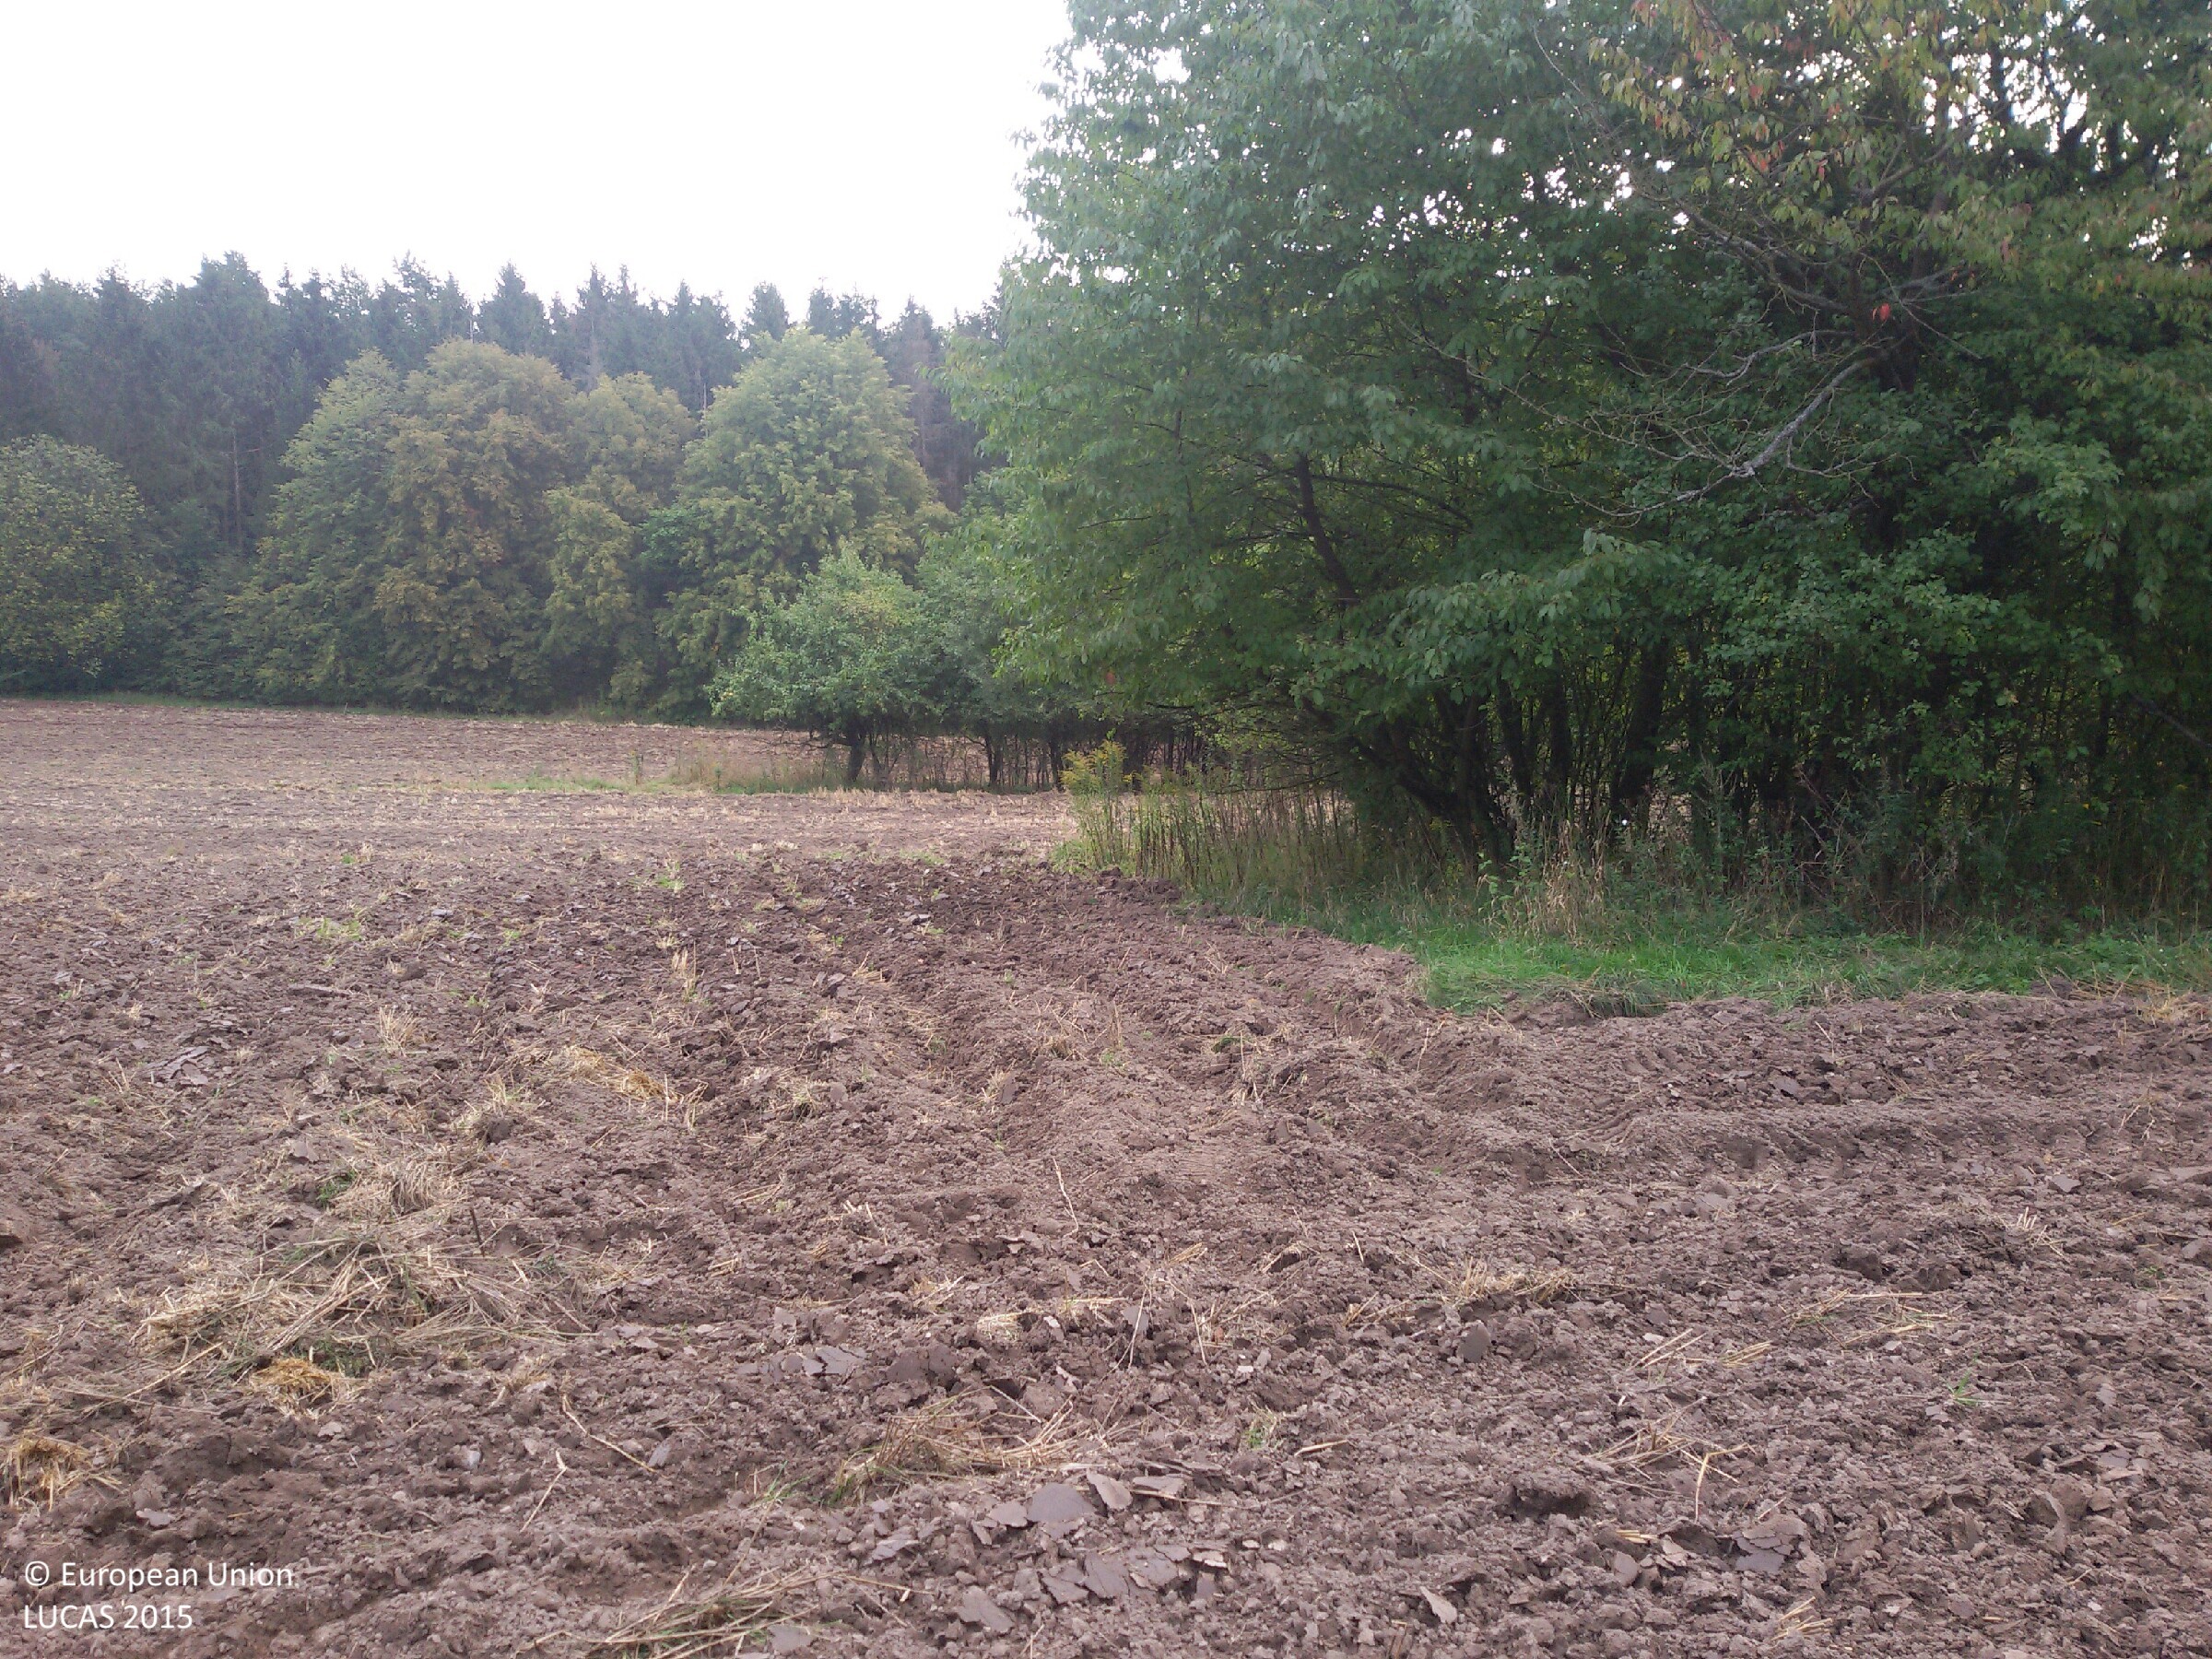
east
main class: Cropland
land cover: Triticale
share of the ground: 10 - 25 %
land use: Agriculture (excluding fallow land and kitchen gardens)
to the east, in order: Triticale; Lines of trees; Grass margins; Triticale; Fences; Grass margins; Spruce dominated mixed woodland; Spruce dominated coniferous woodland; Spontaneously vegetated surfaces
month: September
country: PL
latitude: 54.2128
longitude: 19.3938
